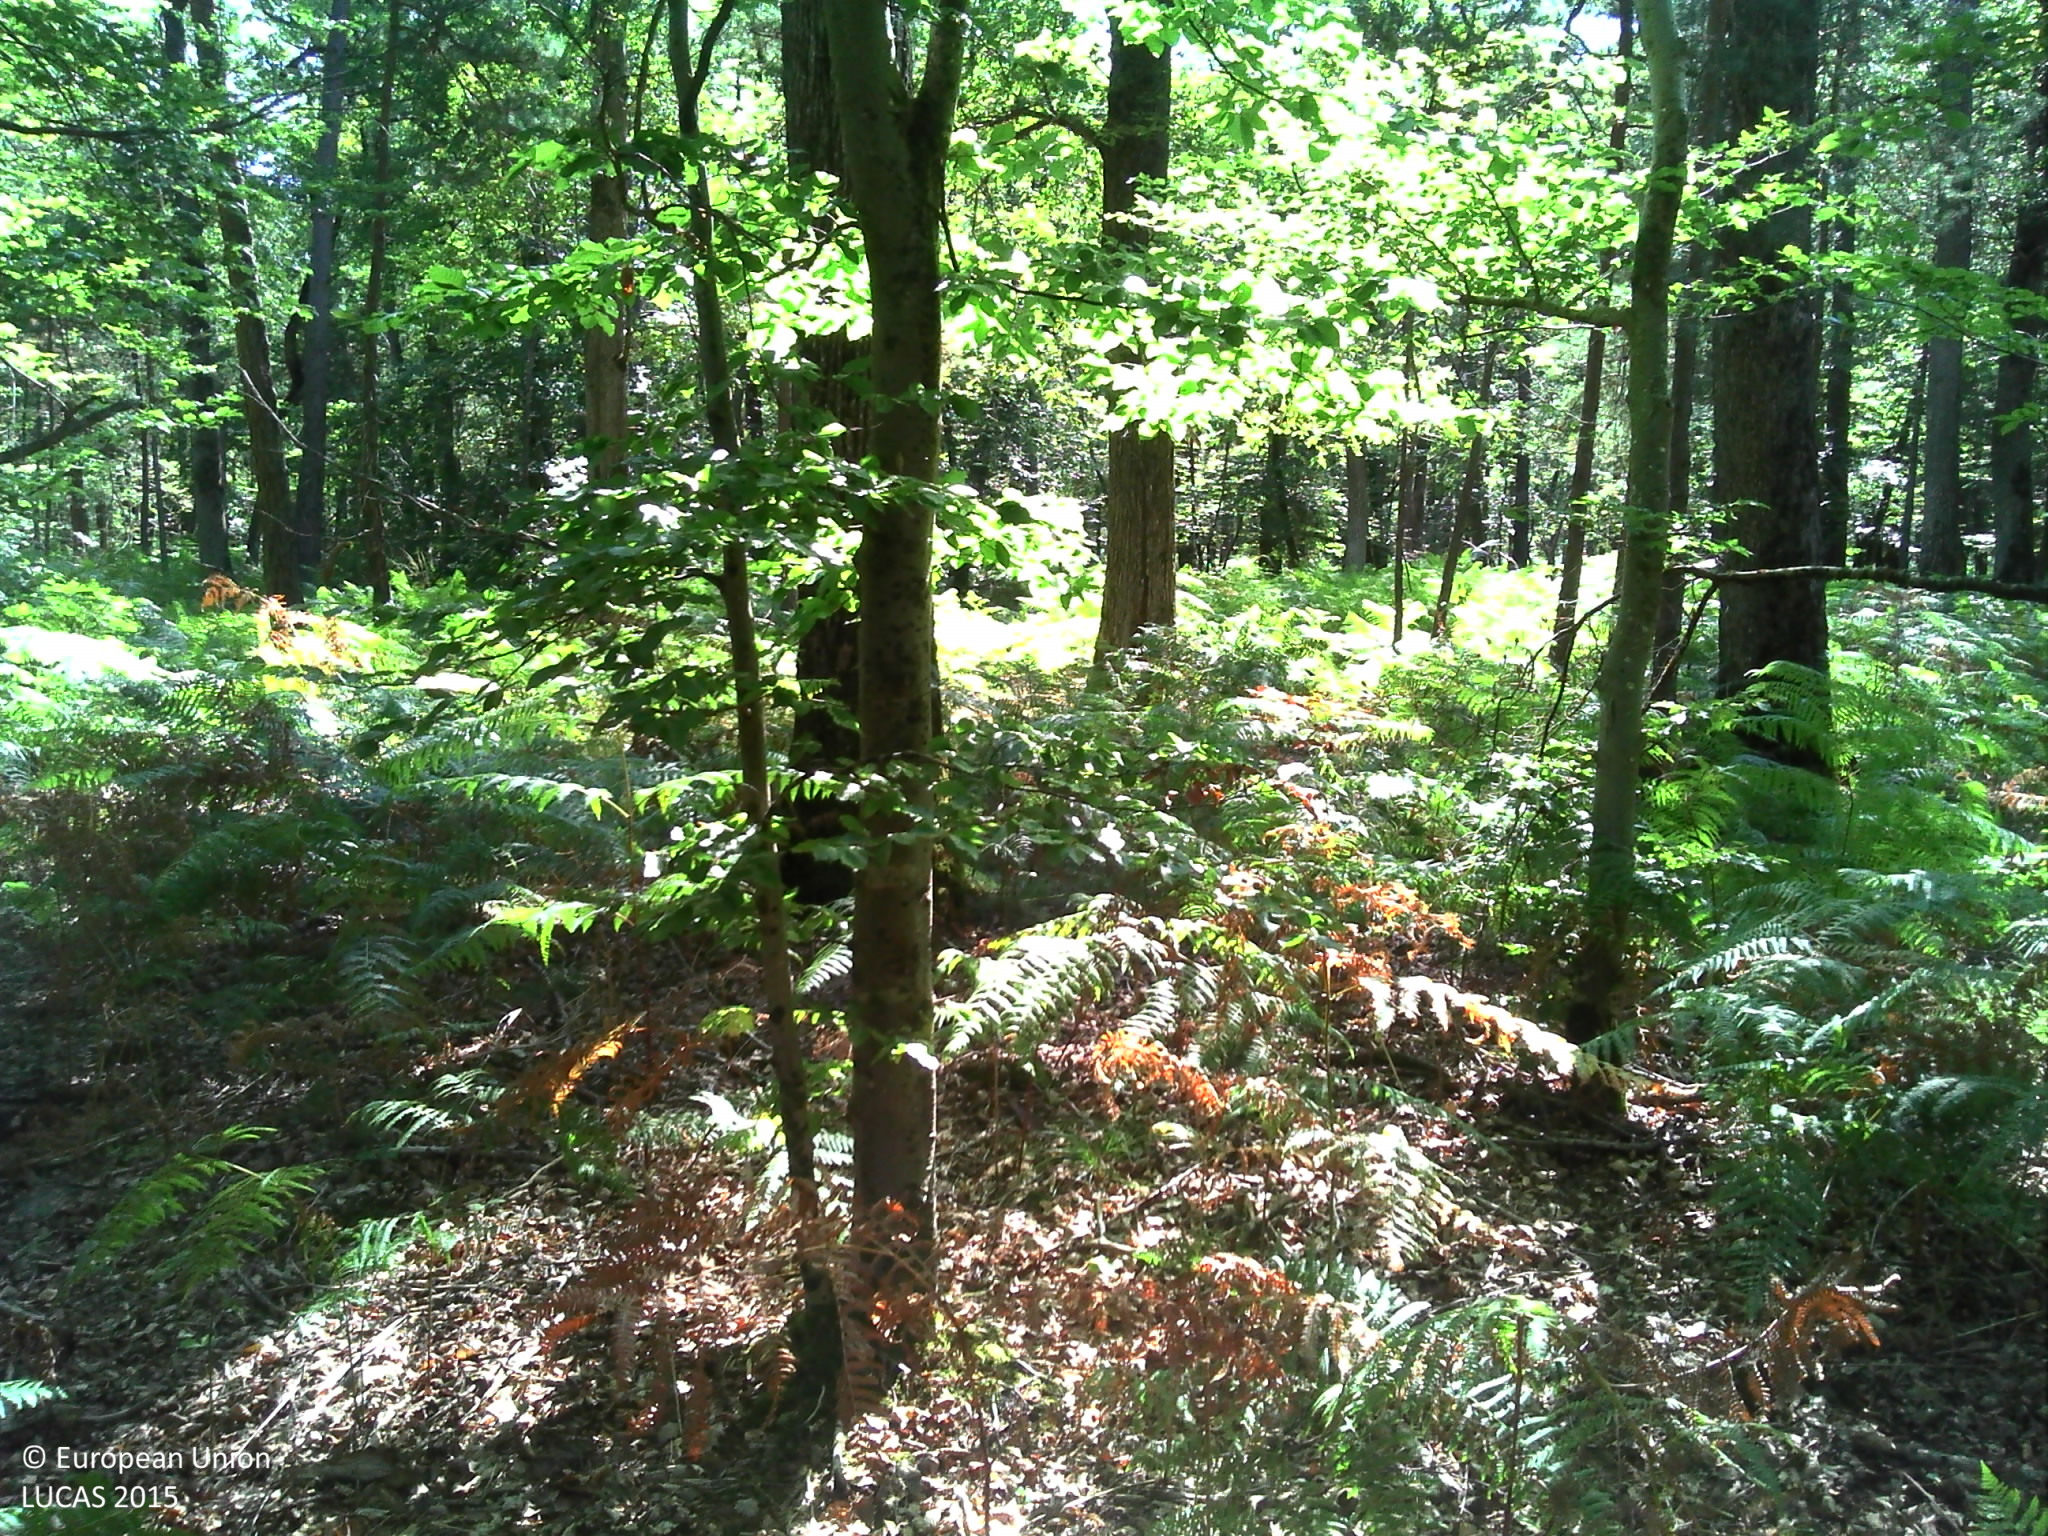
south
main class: Woodland
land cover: Broadleaved woodland
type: beech forest
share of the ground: > 75 %
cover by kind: broadleaved forest trees 75 %, herbaceous plants 10 %, lichens and mosses 10 %, coniferous forest trees 5 %
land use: Forestry
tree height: > 5 m
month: September
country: FR
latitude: 48.3832
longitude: 2.7670
